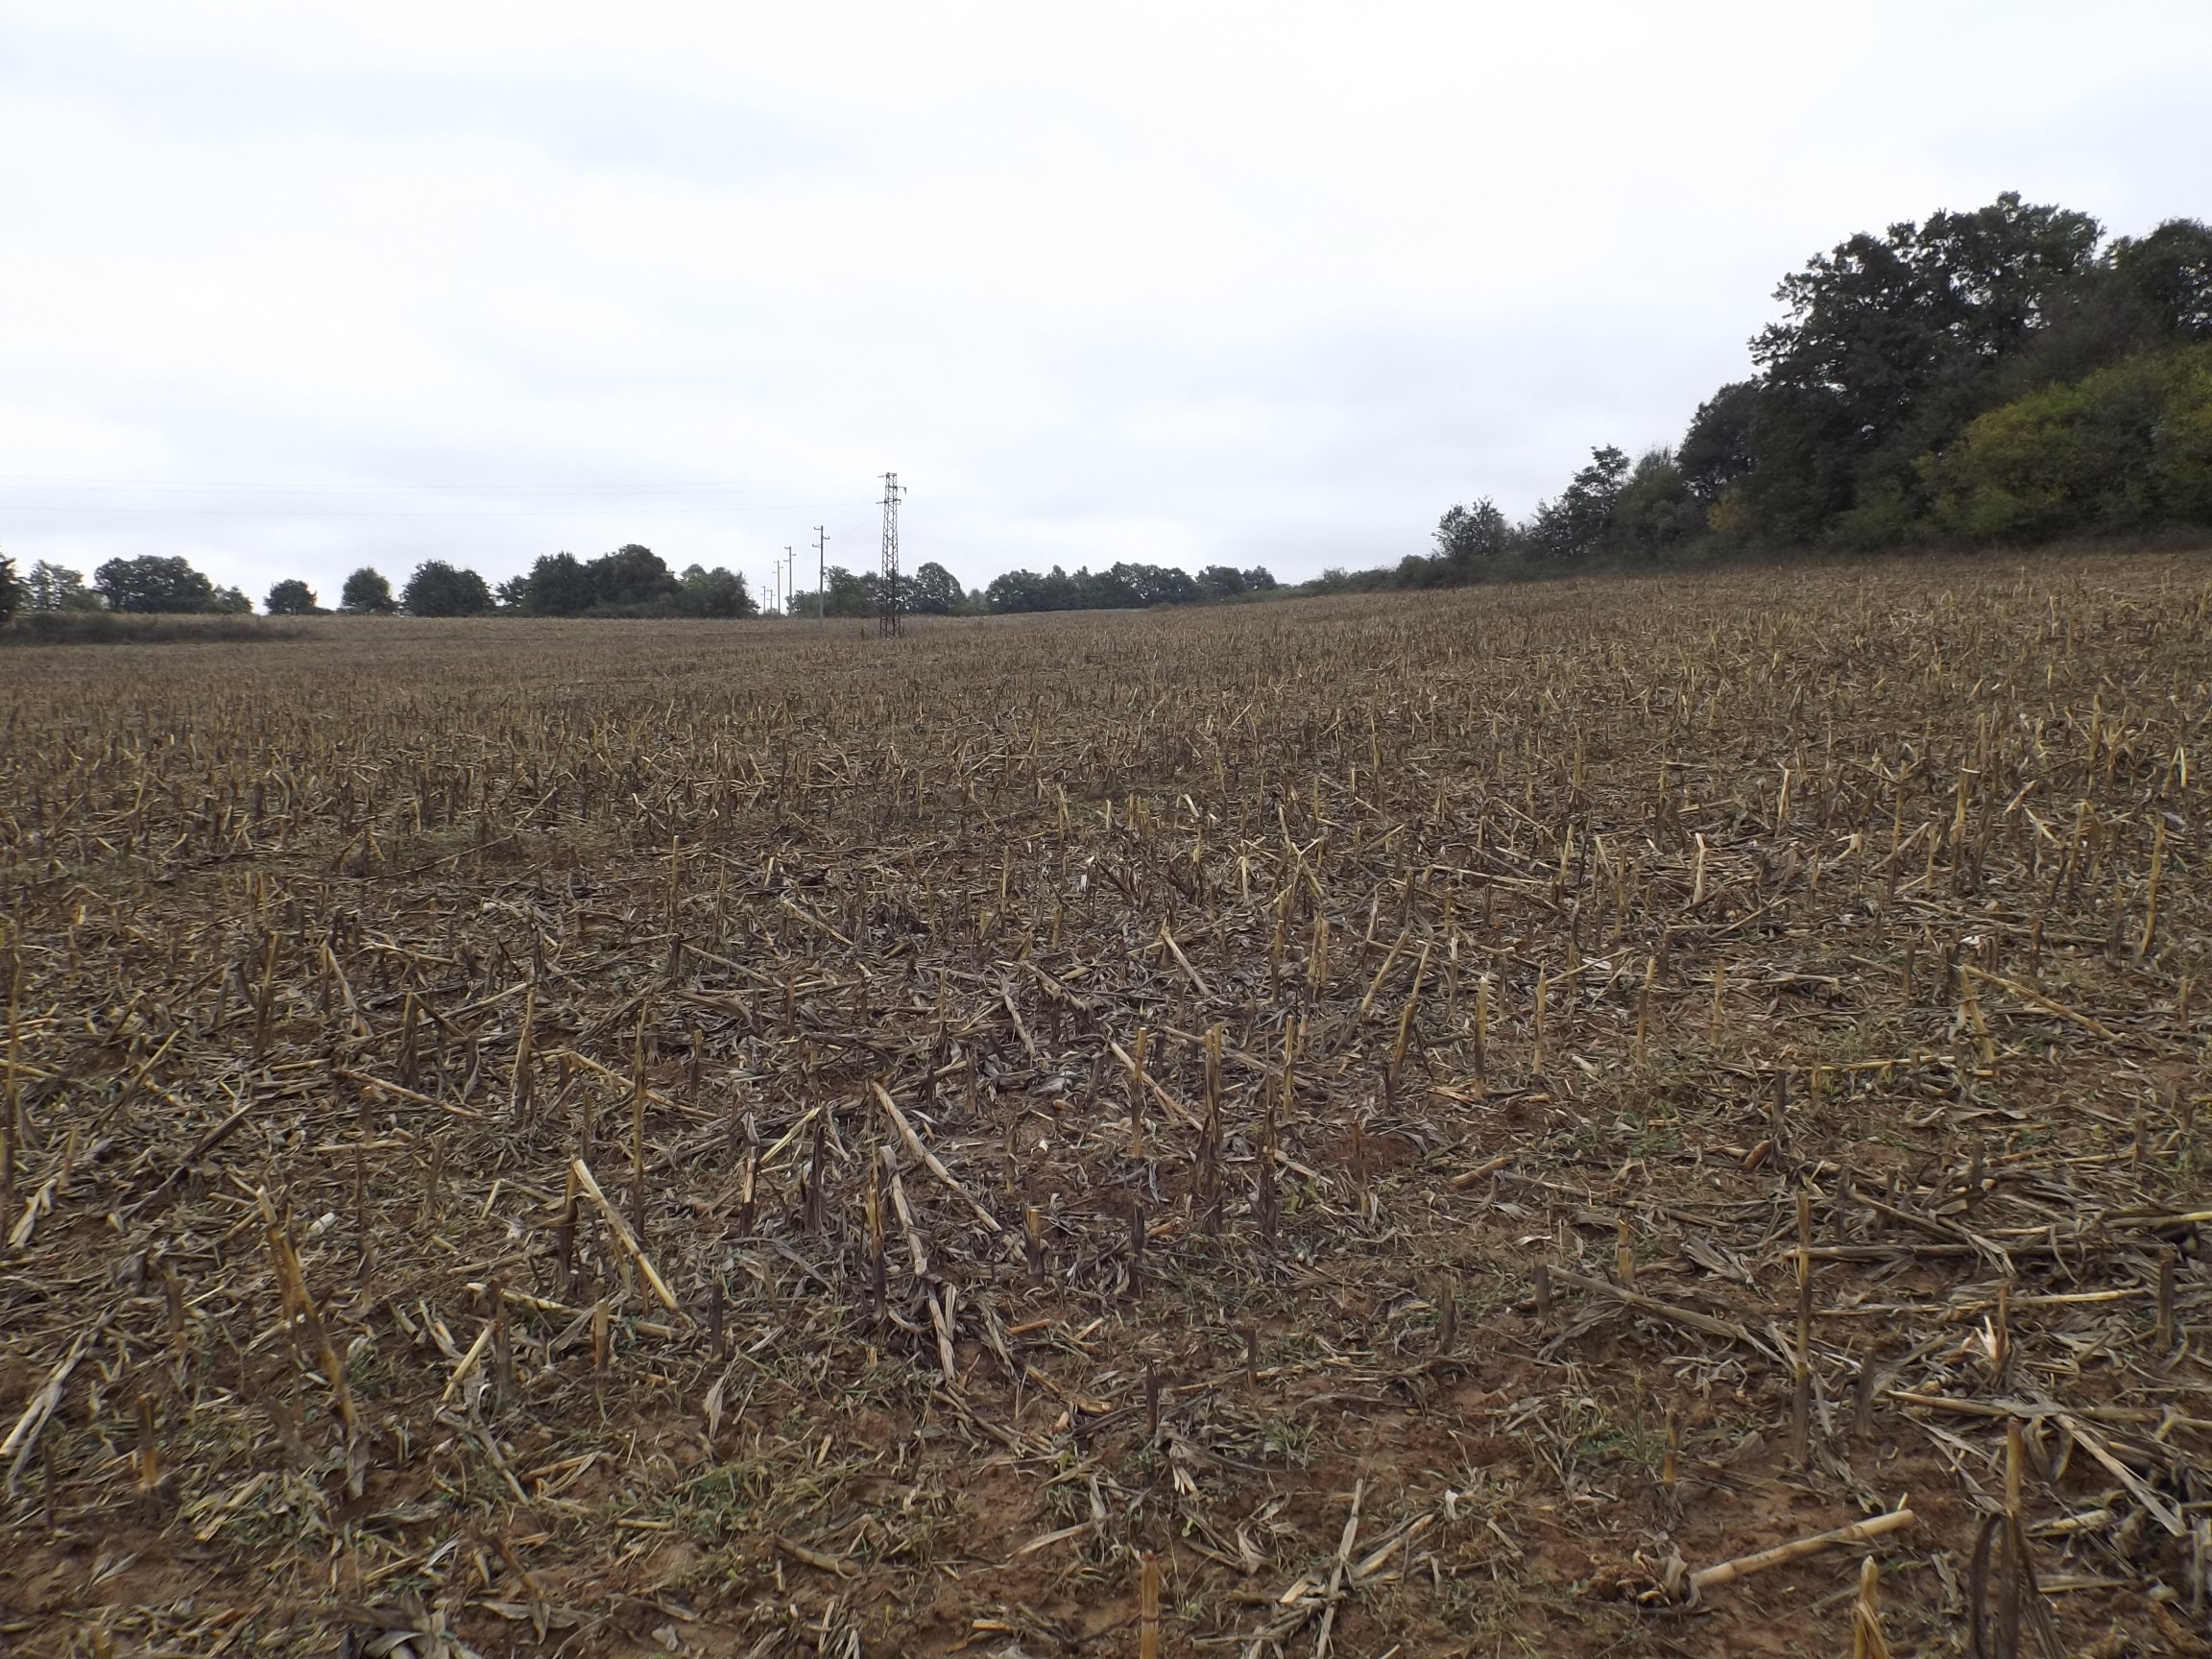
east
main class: Cropland
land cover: Maize
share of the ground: 10 - 25 %
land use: Agriculture (excluding fallow land and kitchen gardens)
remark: Harvested field
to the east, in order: Maize; Shrubland with sparse tree cover; Tracks; Sunflower
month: October
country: BG
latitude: 42.9969
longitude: 27.1780
